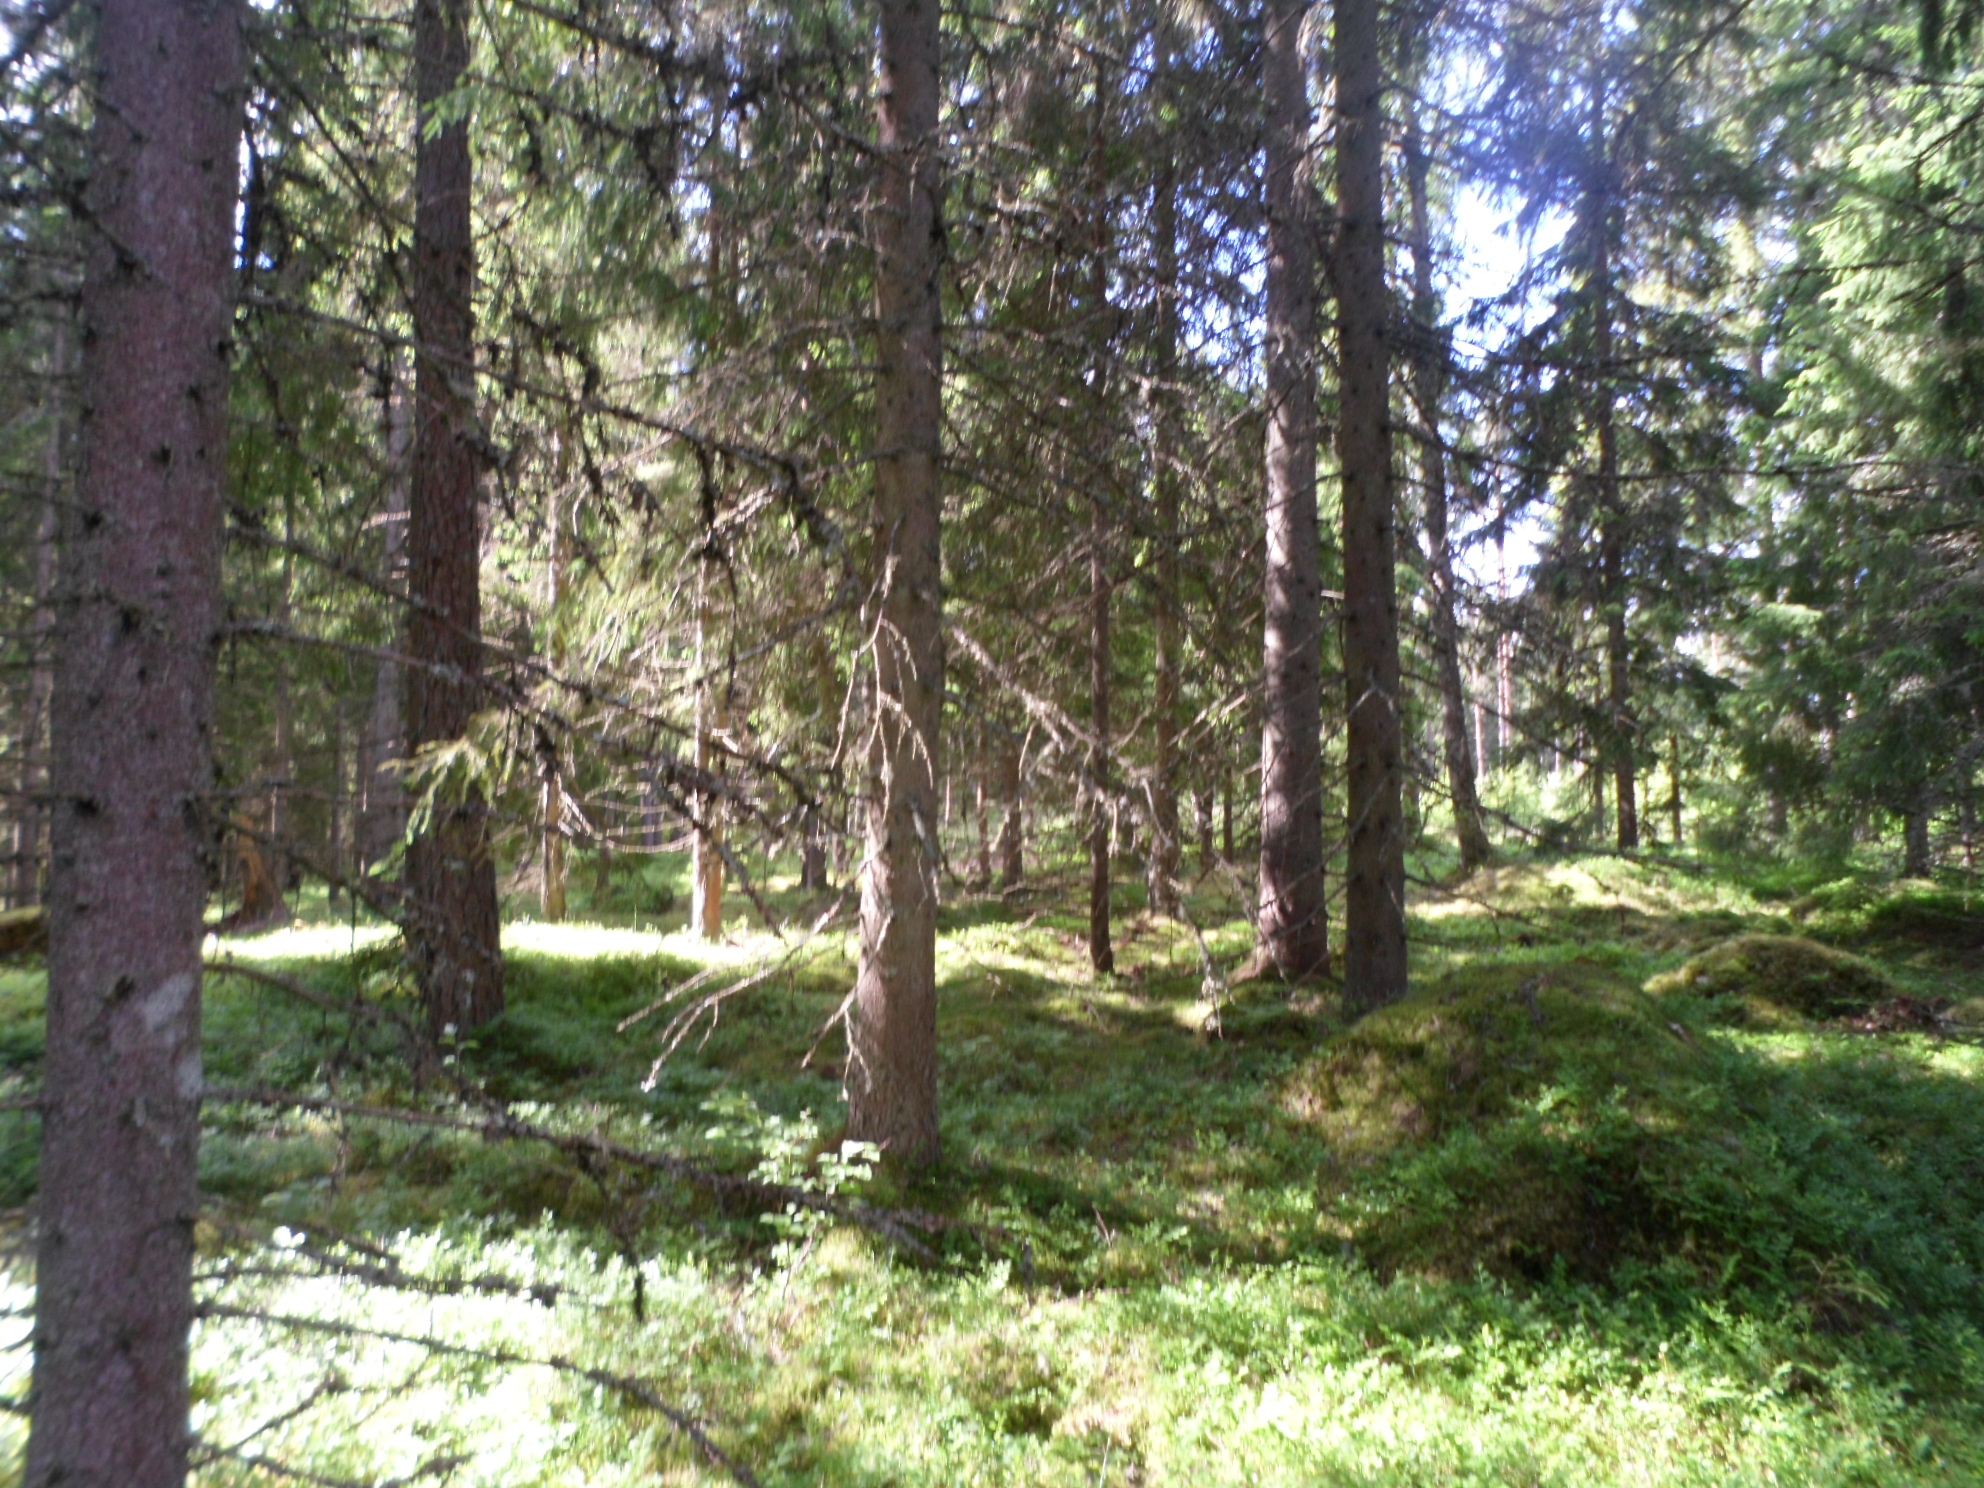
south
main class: Woodland
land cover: Spruce dominated coniferous woodland
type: boreal forest
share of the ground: 50 - 75 %
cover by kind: coniferous forest trees 60 %, lichens and mosses 20 %, shrubs 15 %, herbaceous plants 5 %
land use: Forestry
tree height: > 5 m
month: June
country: SE
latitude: 57.1414
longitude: 14.8386
